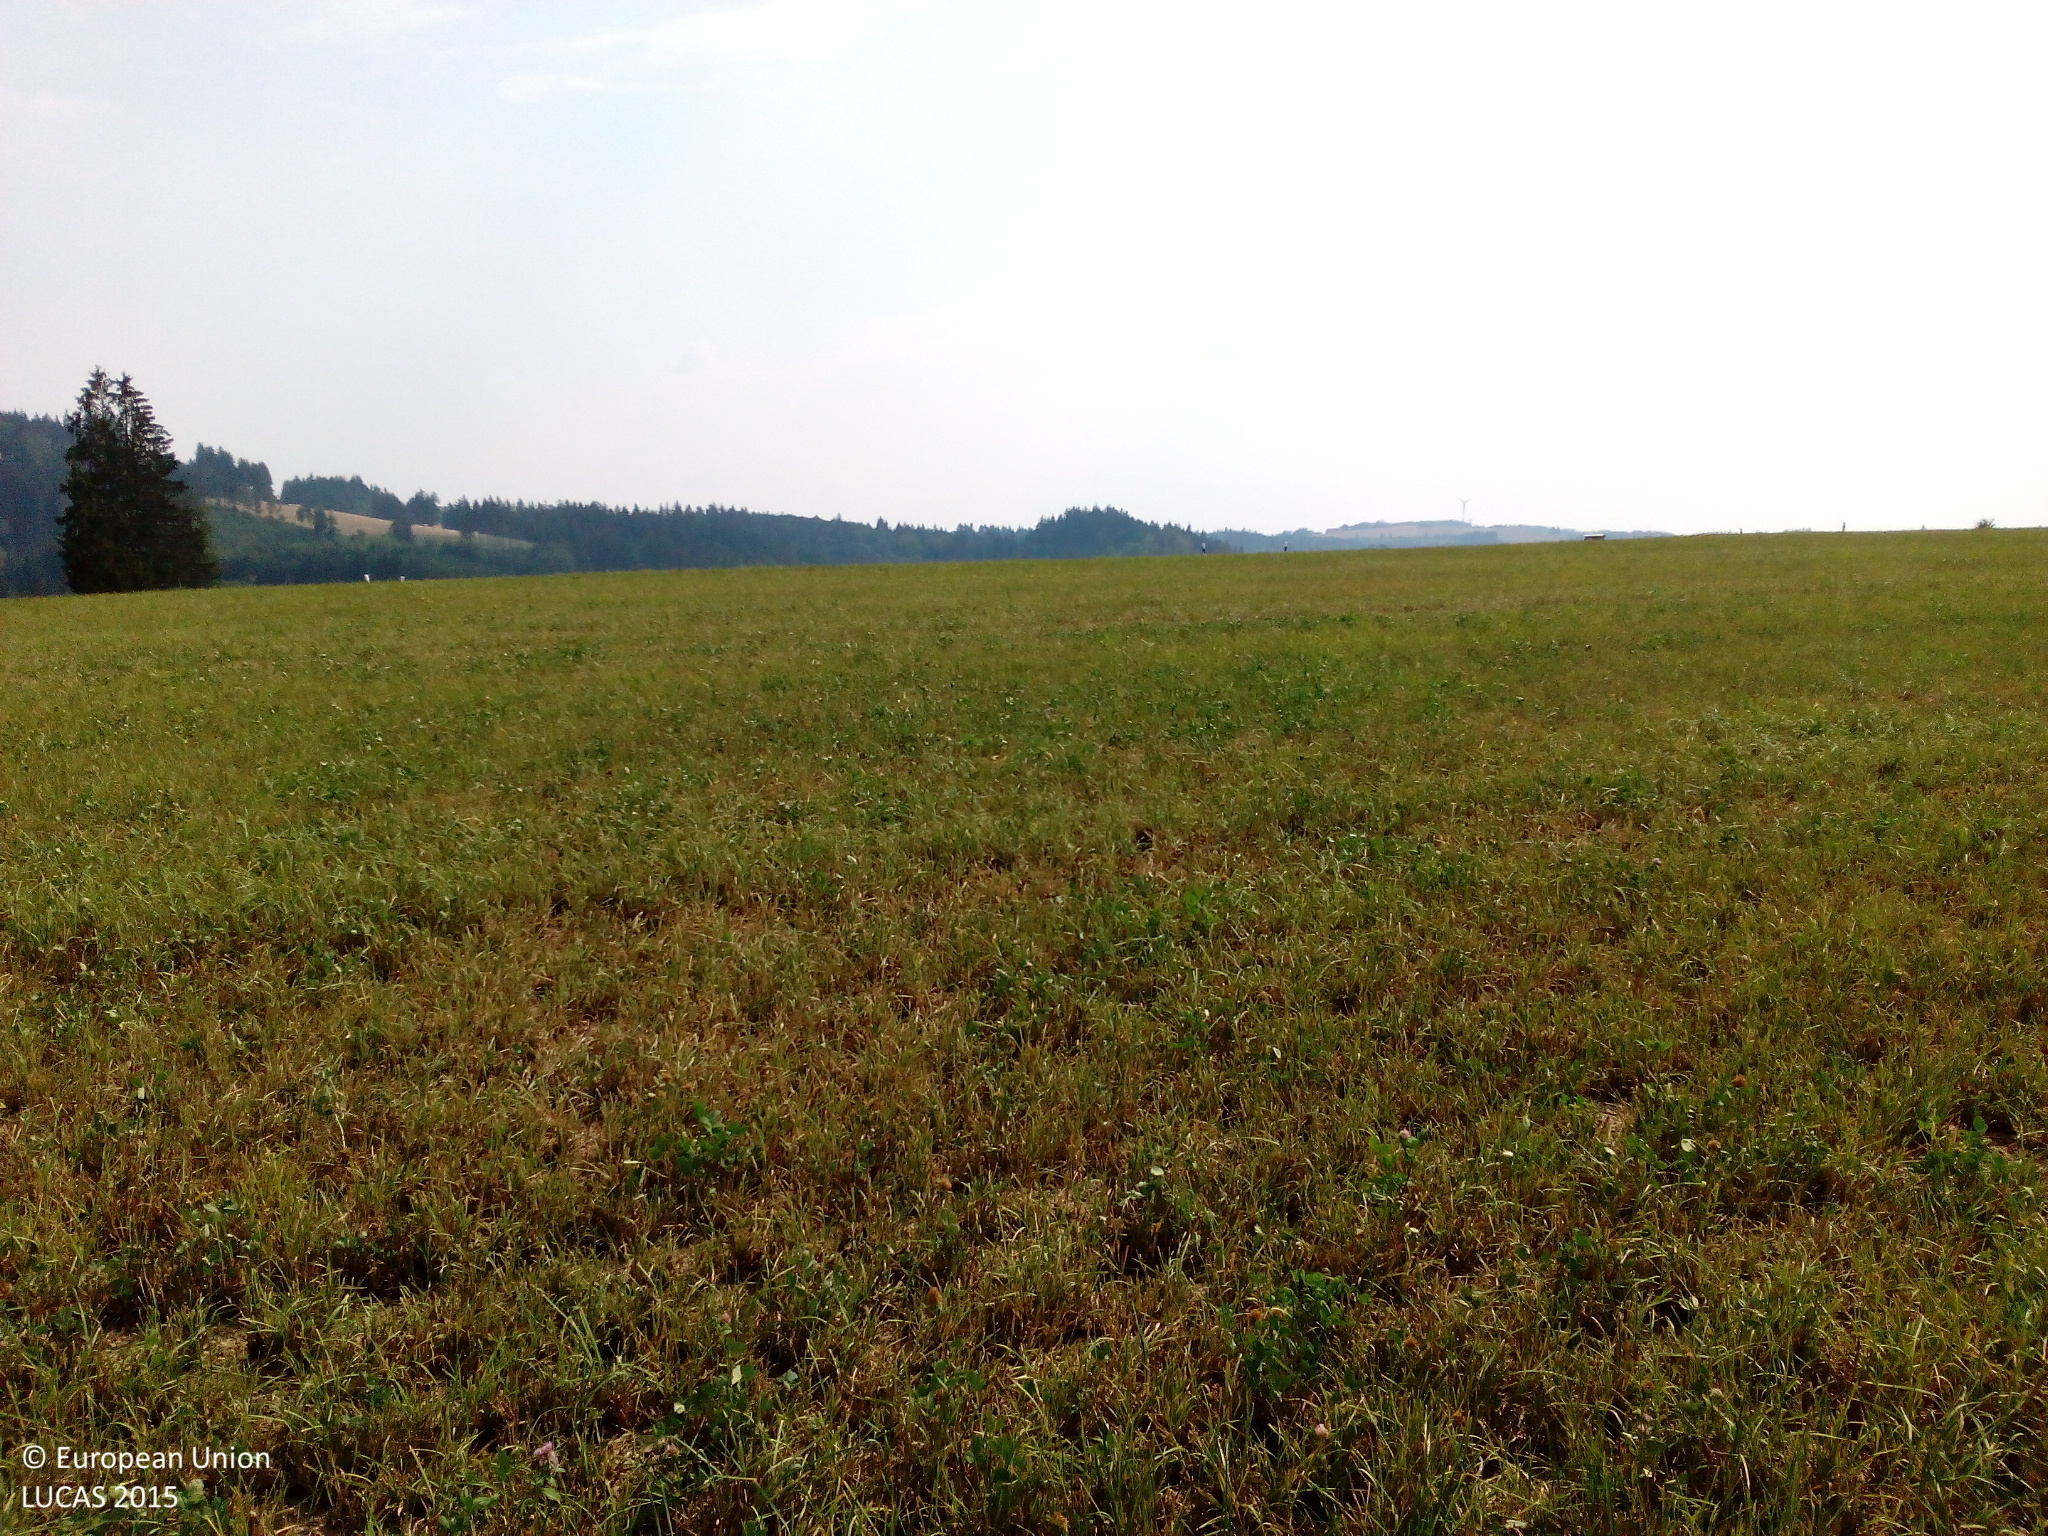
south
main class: Cropland
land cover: Temporary grasslands
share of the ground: 50 - 75 %
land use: Agriculture (excluding fallow land and kitchen gardens)
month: August
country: DE
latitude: 50.2632
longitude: 11.5848
